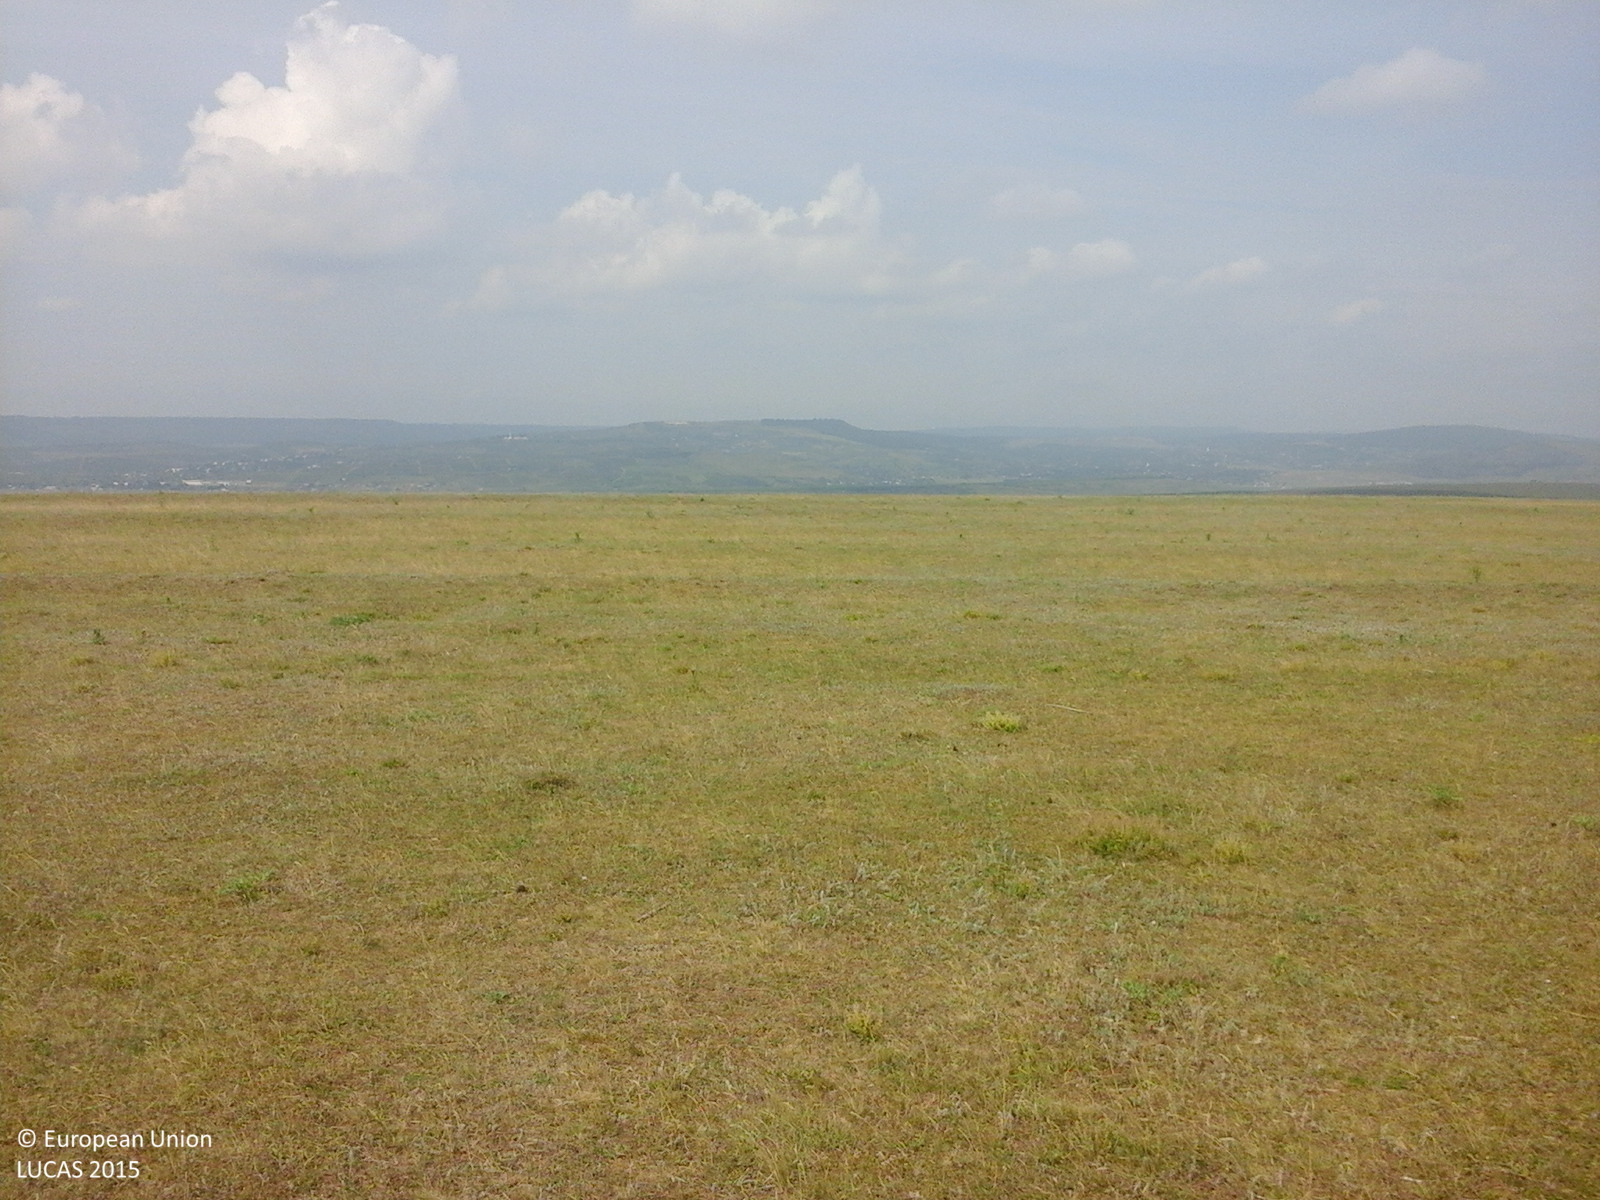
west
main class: Grassland
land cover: Grassland without tree/shrub cover
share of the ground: > 75 %
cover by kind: herbaceous plants 100 %
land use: Agriculture (excluding fallow land and kitchen gardens)
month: June
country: RO
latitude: 47.3662
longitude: 27.0122
